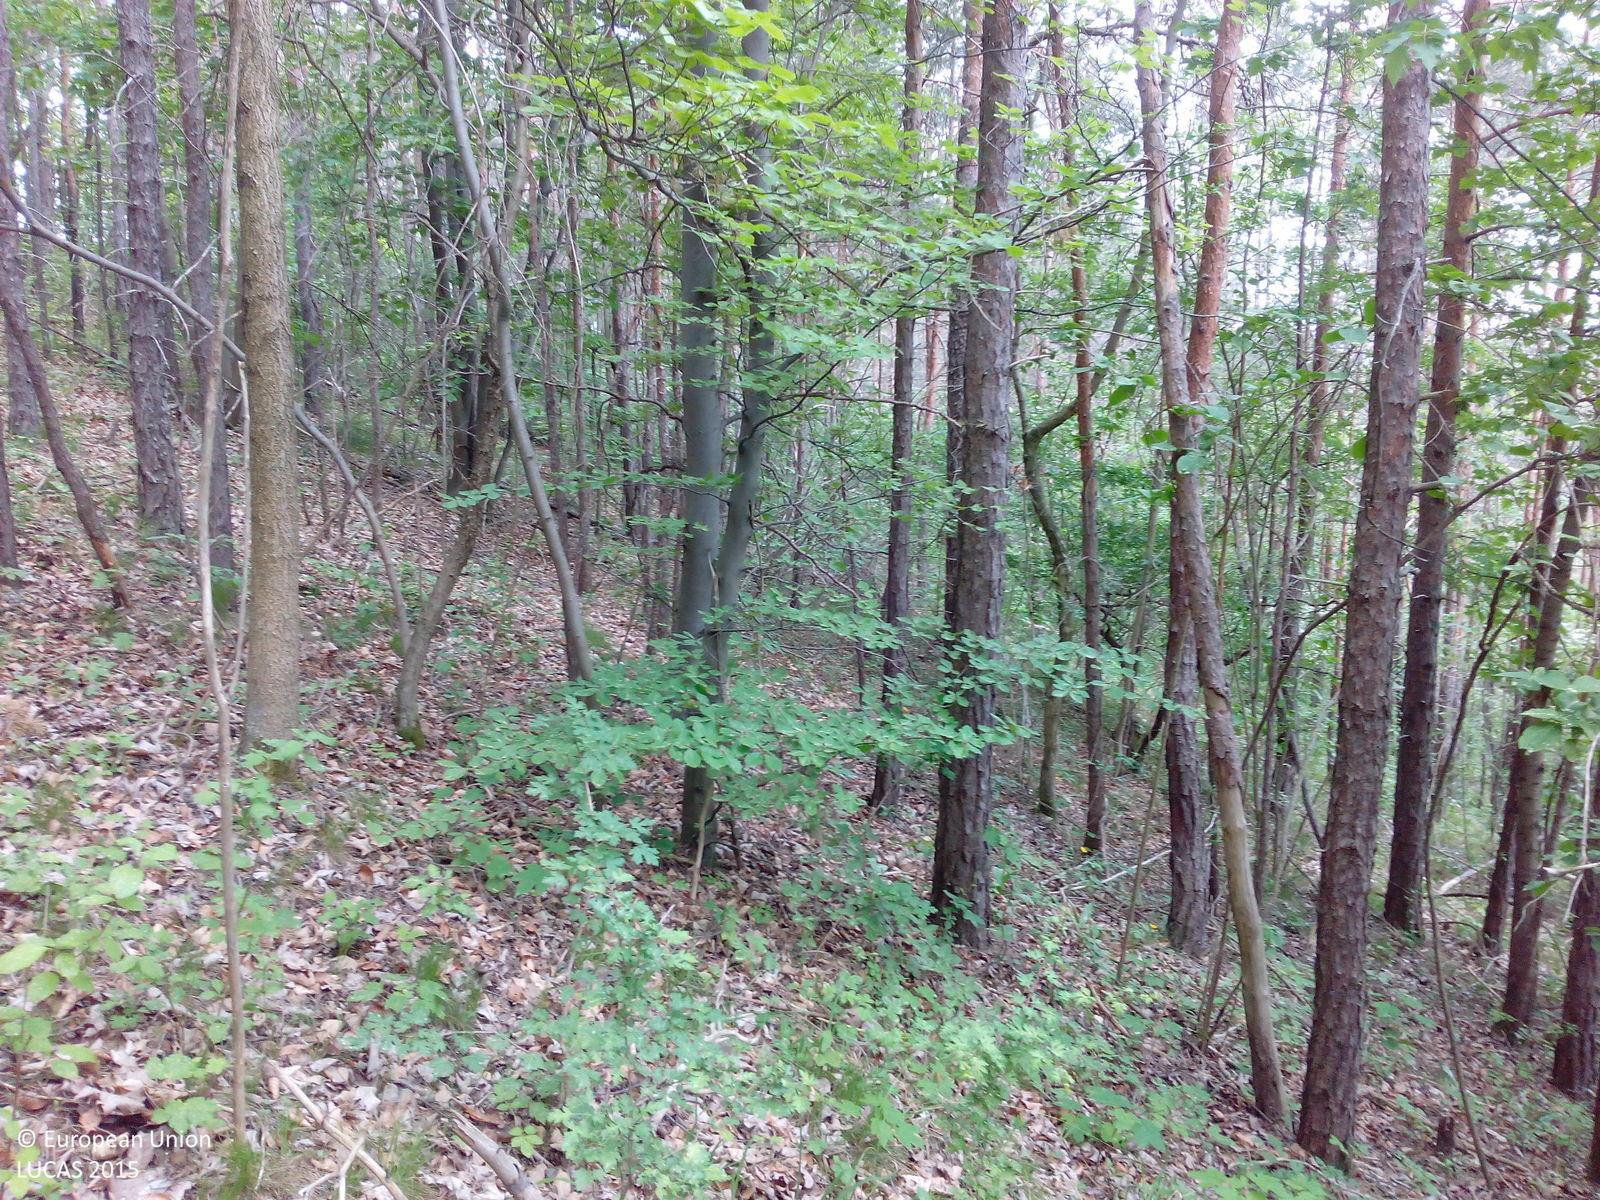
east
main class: Woodland
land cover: Pine dominated mixed woodland
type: hemiboreal forest and nemoral coniferous forest and mixed broadleaved-coniferous forest
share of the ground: > 75 %
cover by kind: coniferous forest trees 75 %, broadleaved forest trees 25 %
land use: Forestry
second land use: Amenities, museums, leisure
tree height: > 5 m
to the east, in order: Pine dominated mixed woodland; Fences; Broadleaved woodland; Tracks; Fences; Grassland without tree/shrub cover; Electric lines; Grassland without tree/shrub cover
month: May
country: DE
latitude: 50.9110
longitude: 11.5499
